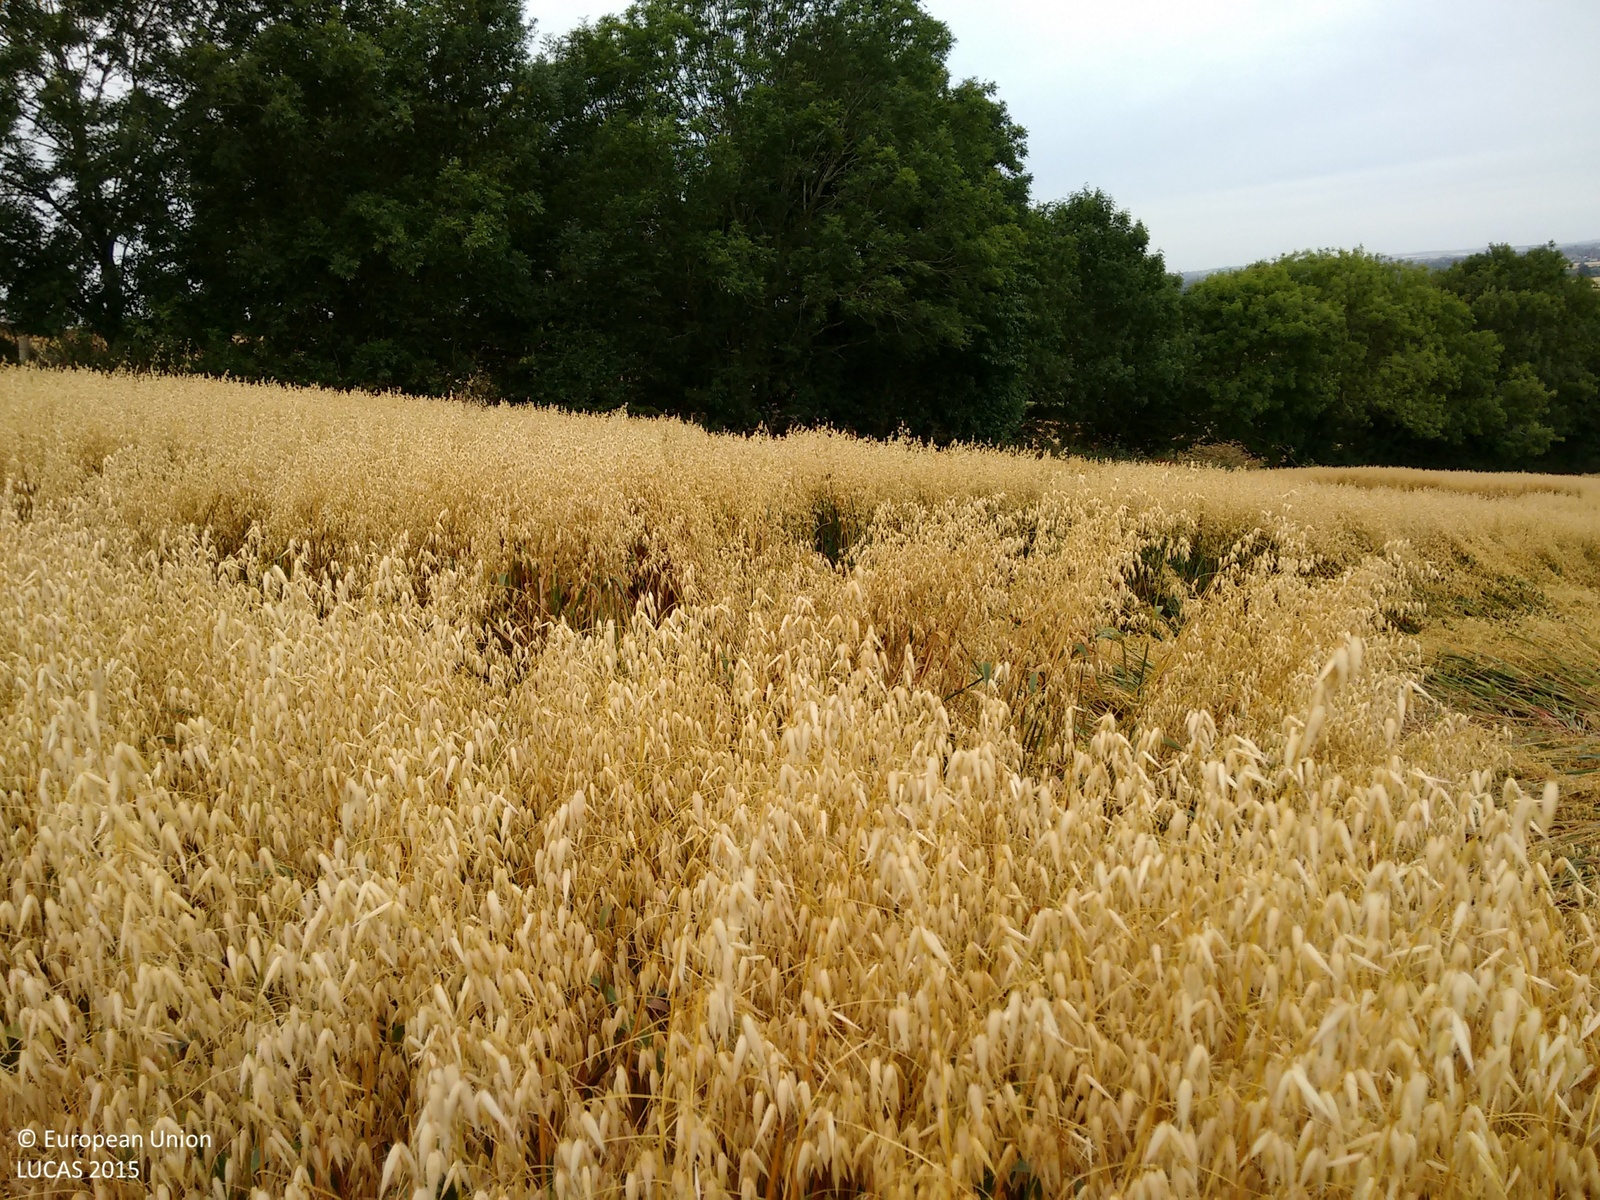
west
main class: Woodland
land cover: Broadleaved woodland
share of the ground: > 75 %
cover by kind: broadleaved forest trees 95 %, shrubs 5 %
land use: Semi-natural and natural areas not in use
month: August
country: GB
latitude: 52.0042
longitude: -1.2499
